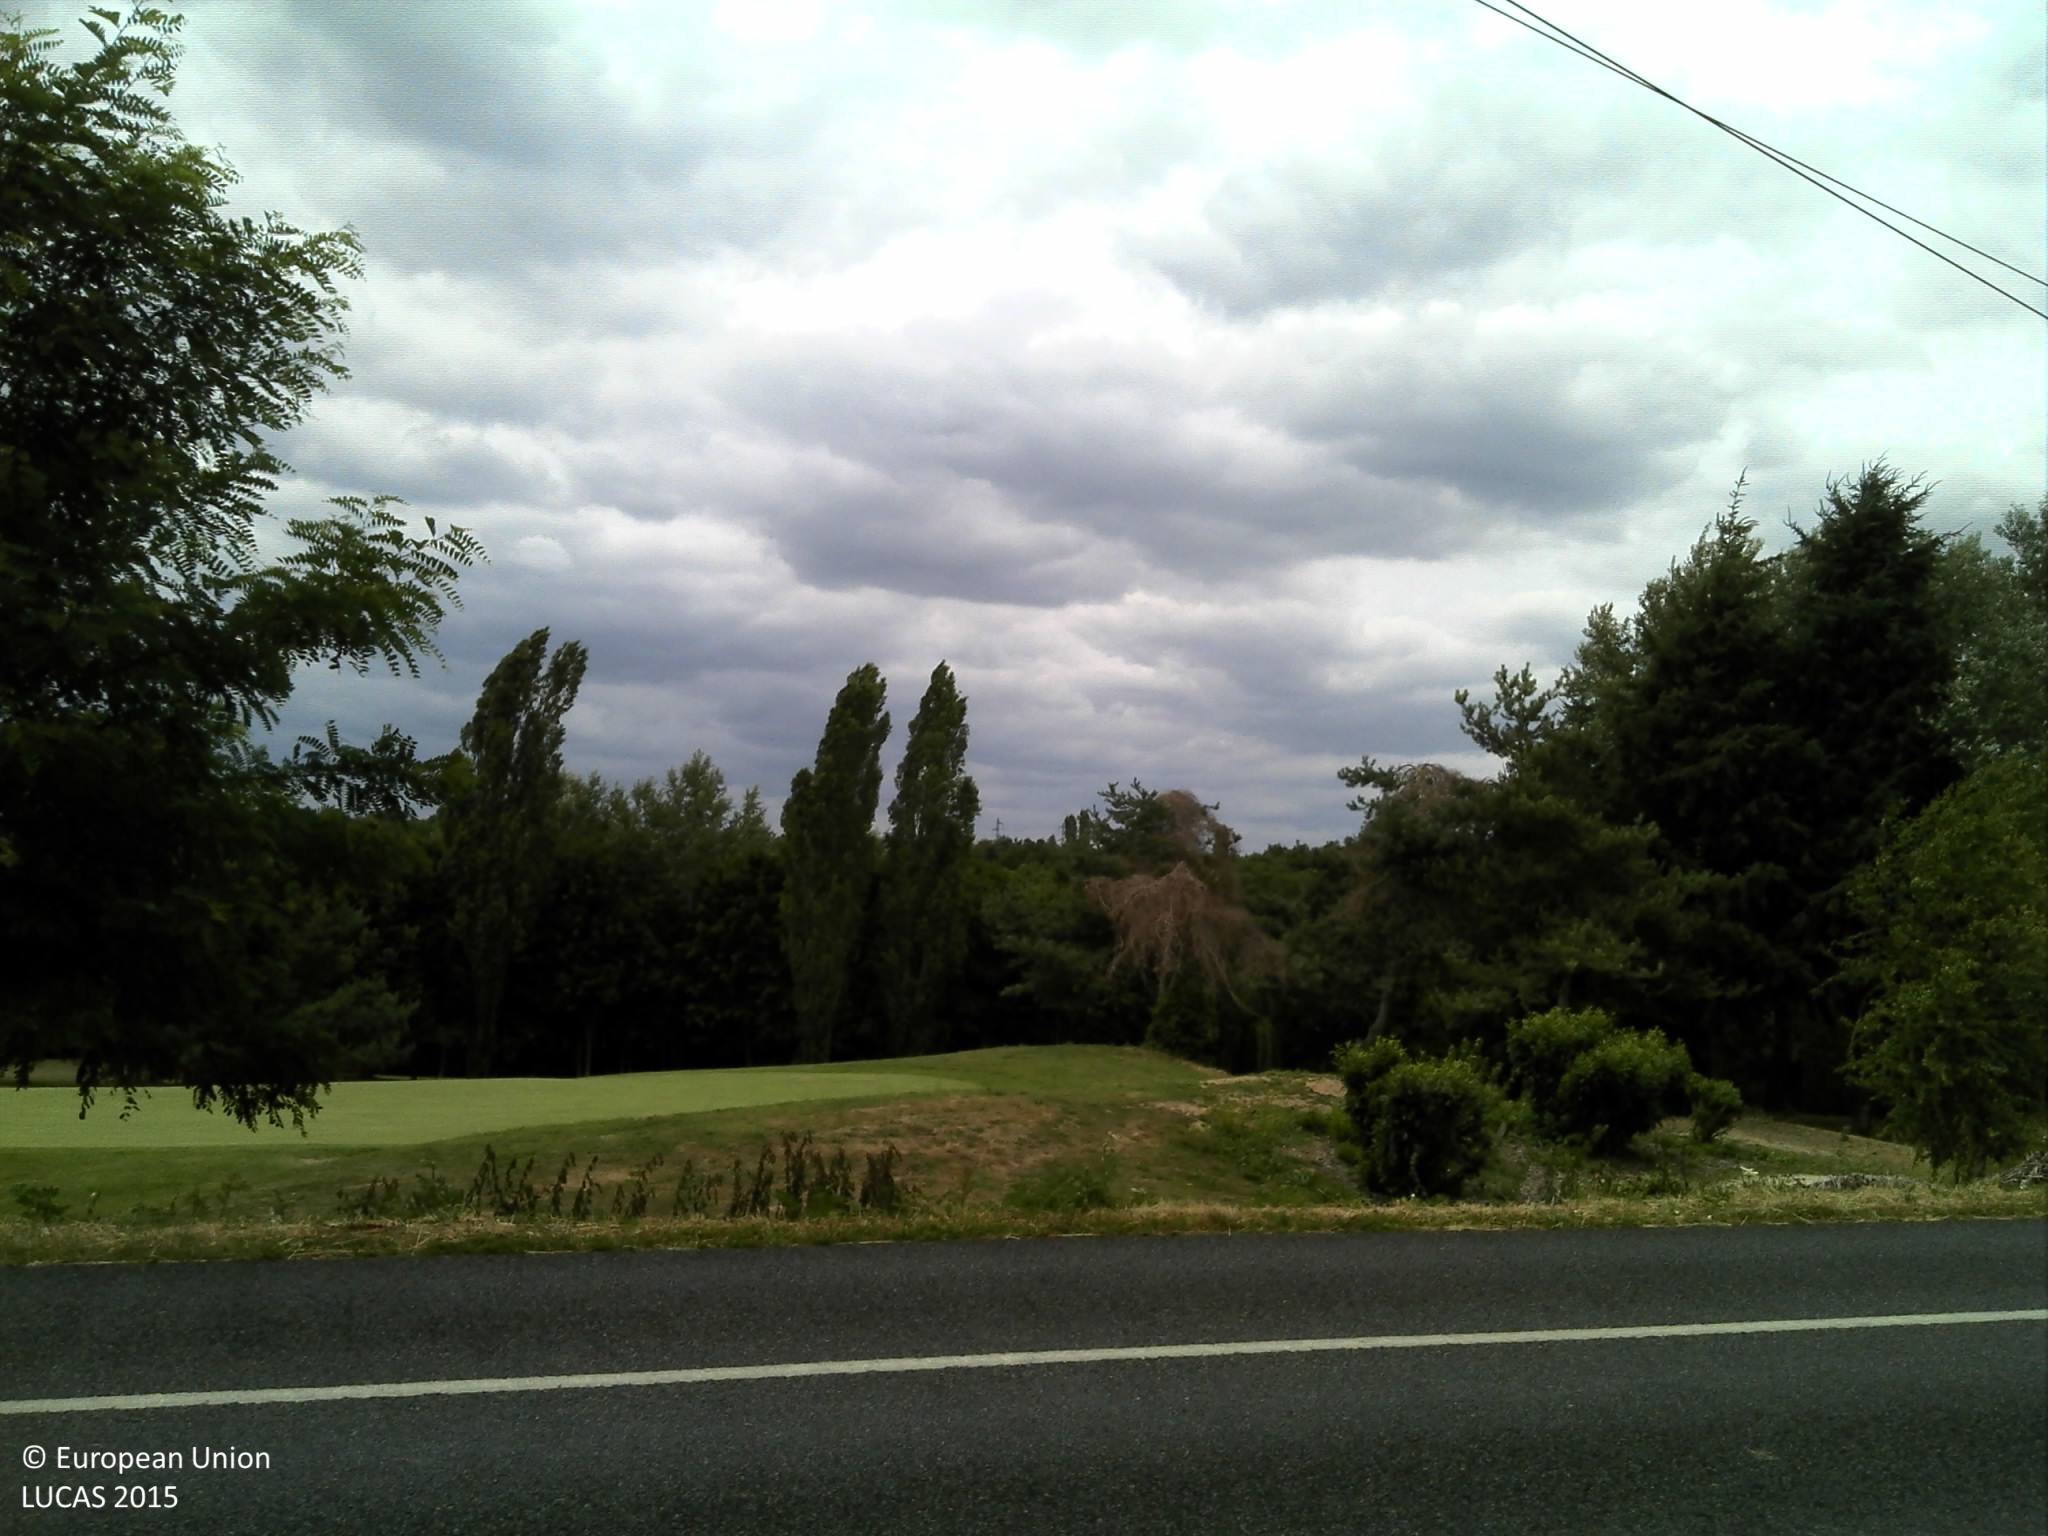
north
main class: Woodland
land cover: Broadleaved woodland
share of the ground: > 75 %
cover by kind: broadleaved forest trees 50 %, herbaceous plants 35 %, consolidated bare surface 15 %
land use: Sport
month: July
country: FR
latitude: 48.6354
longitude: 2.4849
